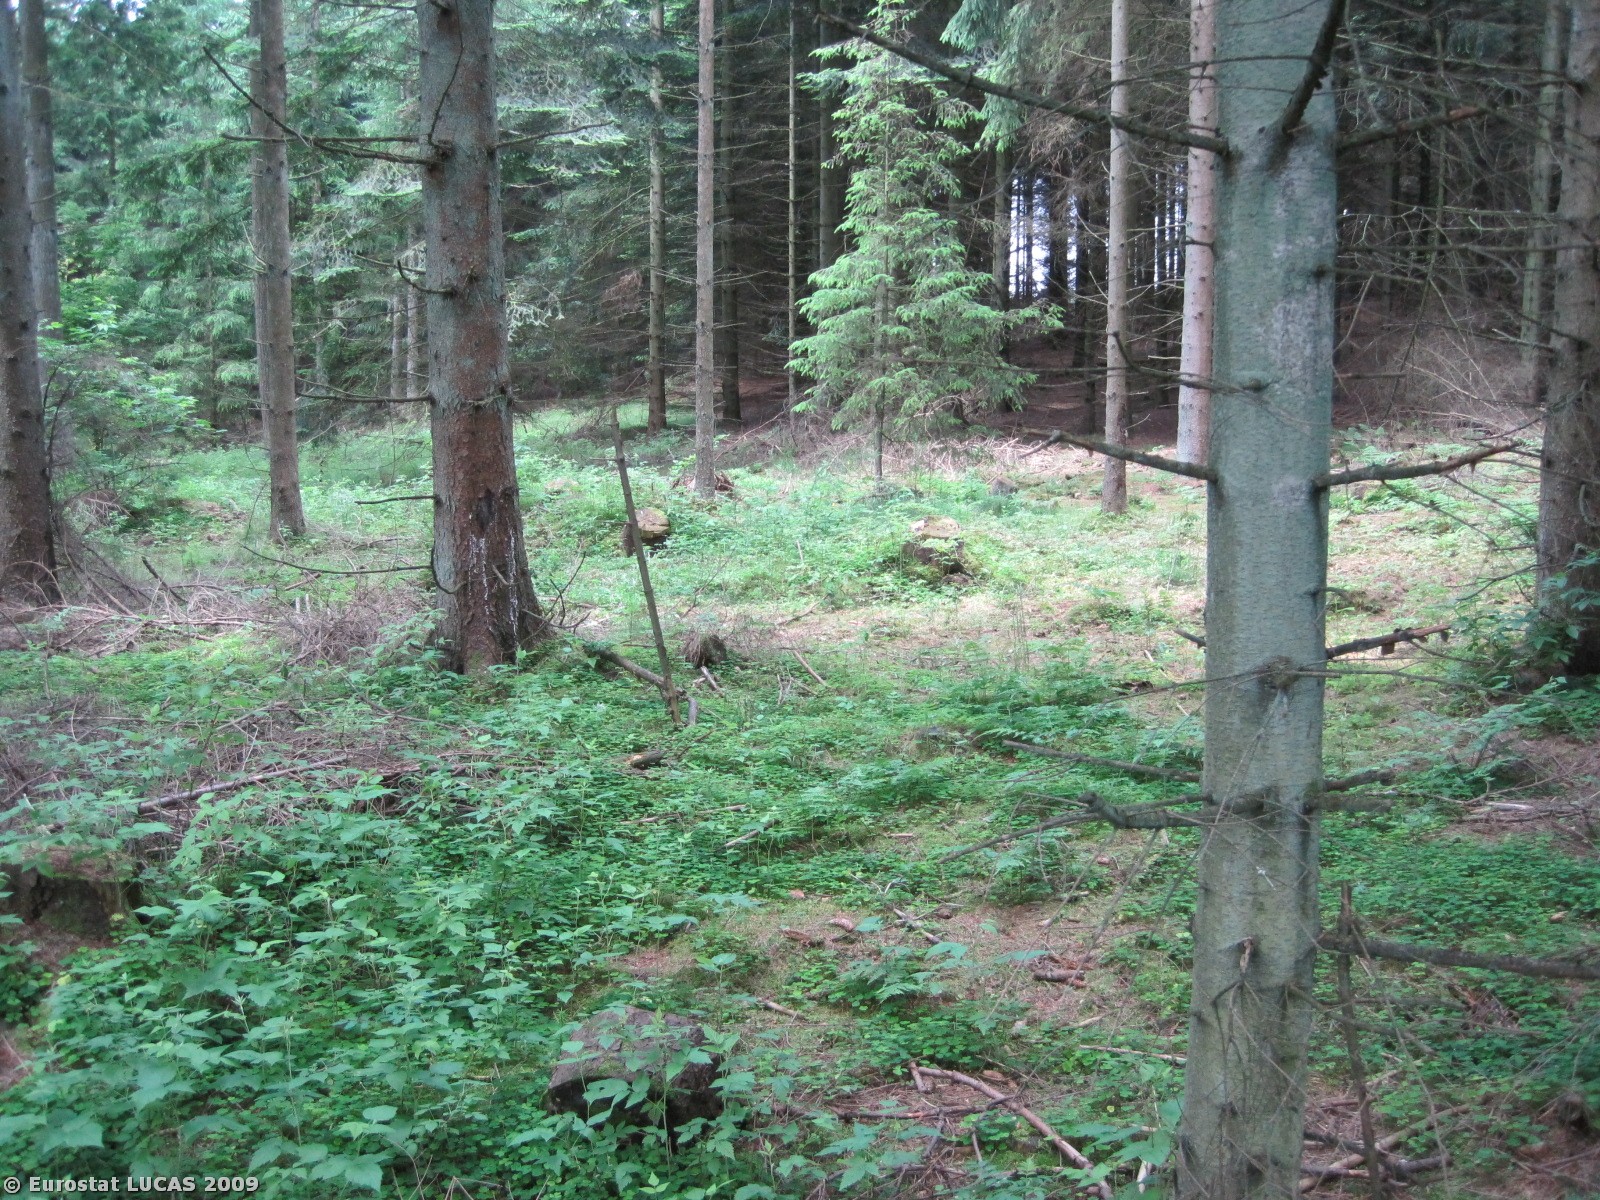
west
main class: Woodland
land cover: Coniferous woodland
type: plantations and self-sown exotic forest
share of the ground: 50 - 75 %
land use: Forestry
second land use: Amenities, museums, leisure
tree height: > 5 m
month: June
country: DK
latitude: 57.1942
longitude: 10.2478
